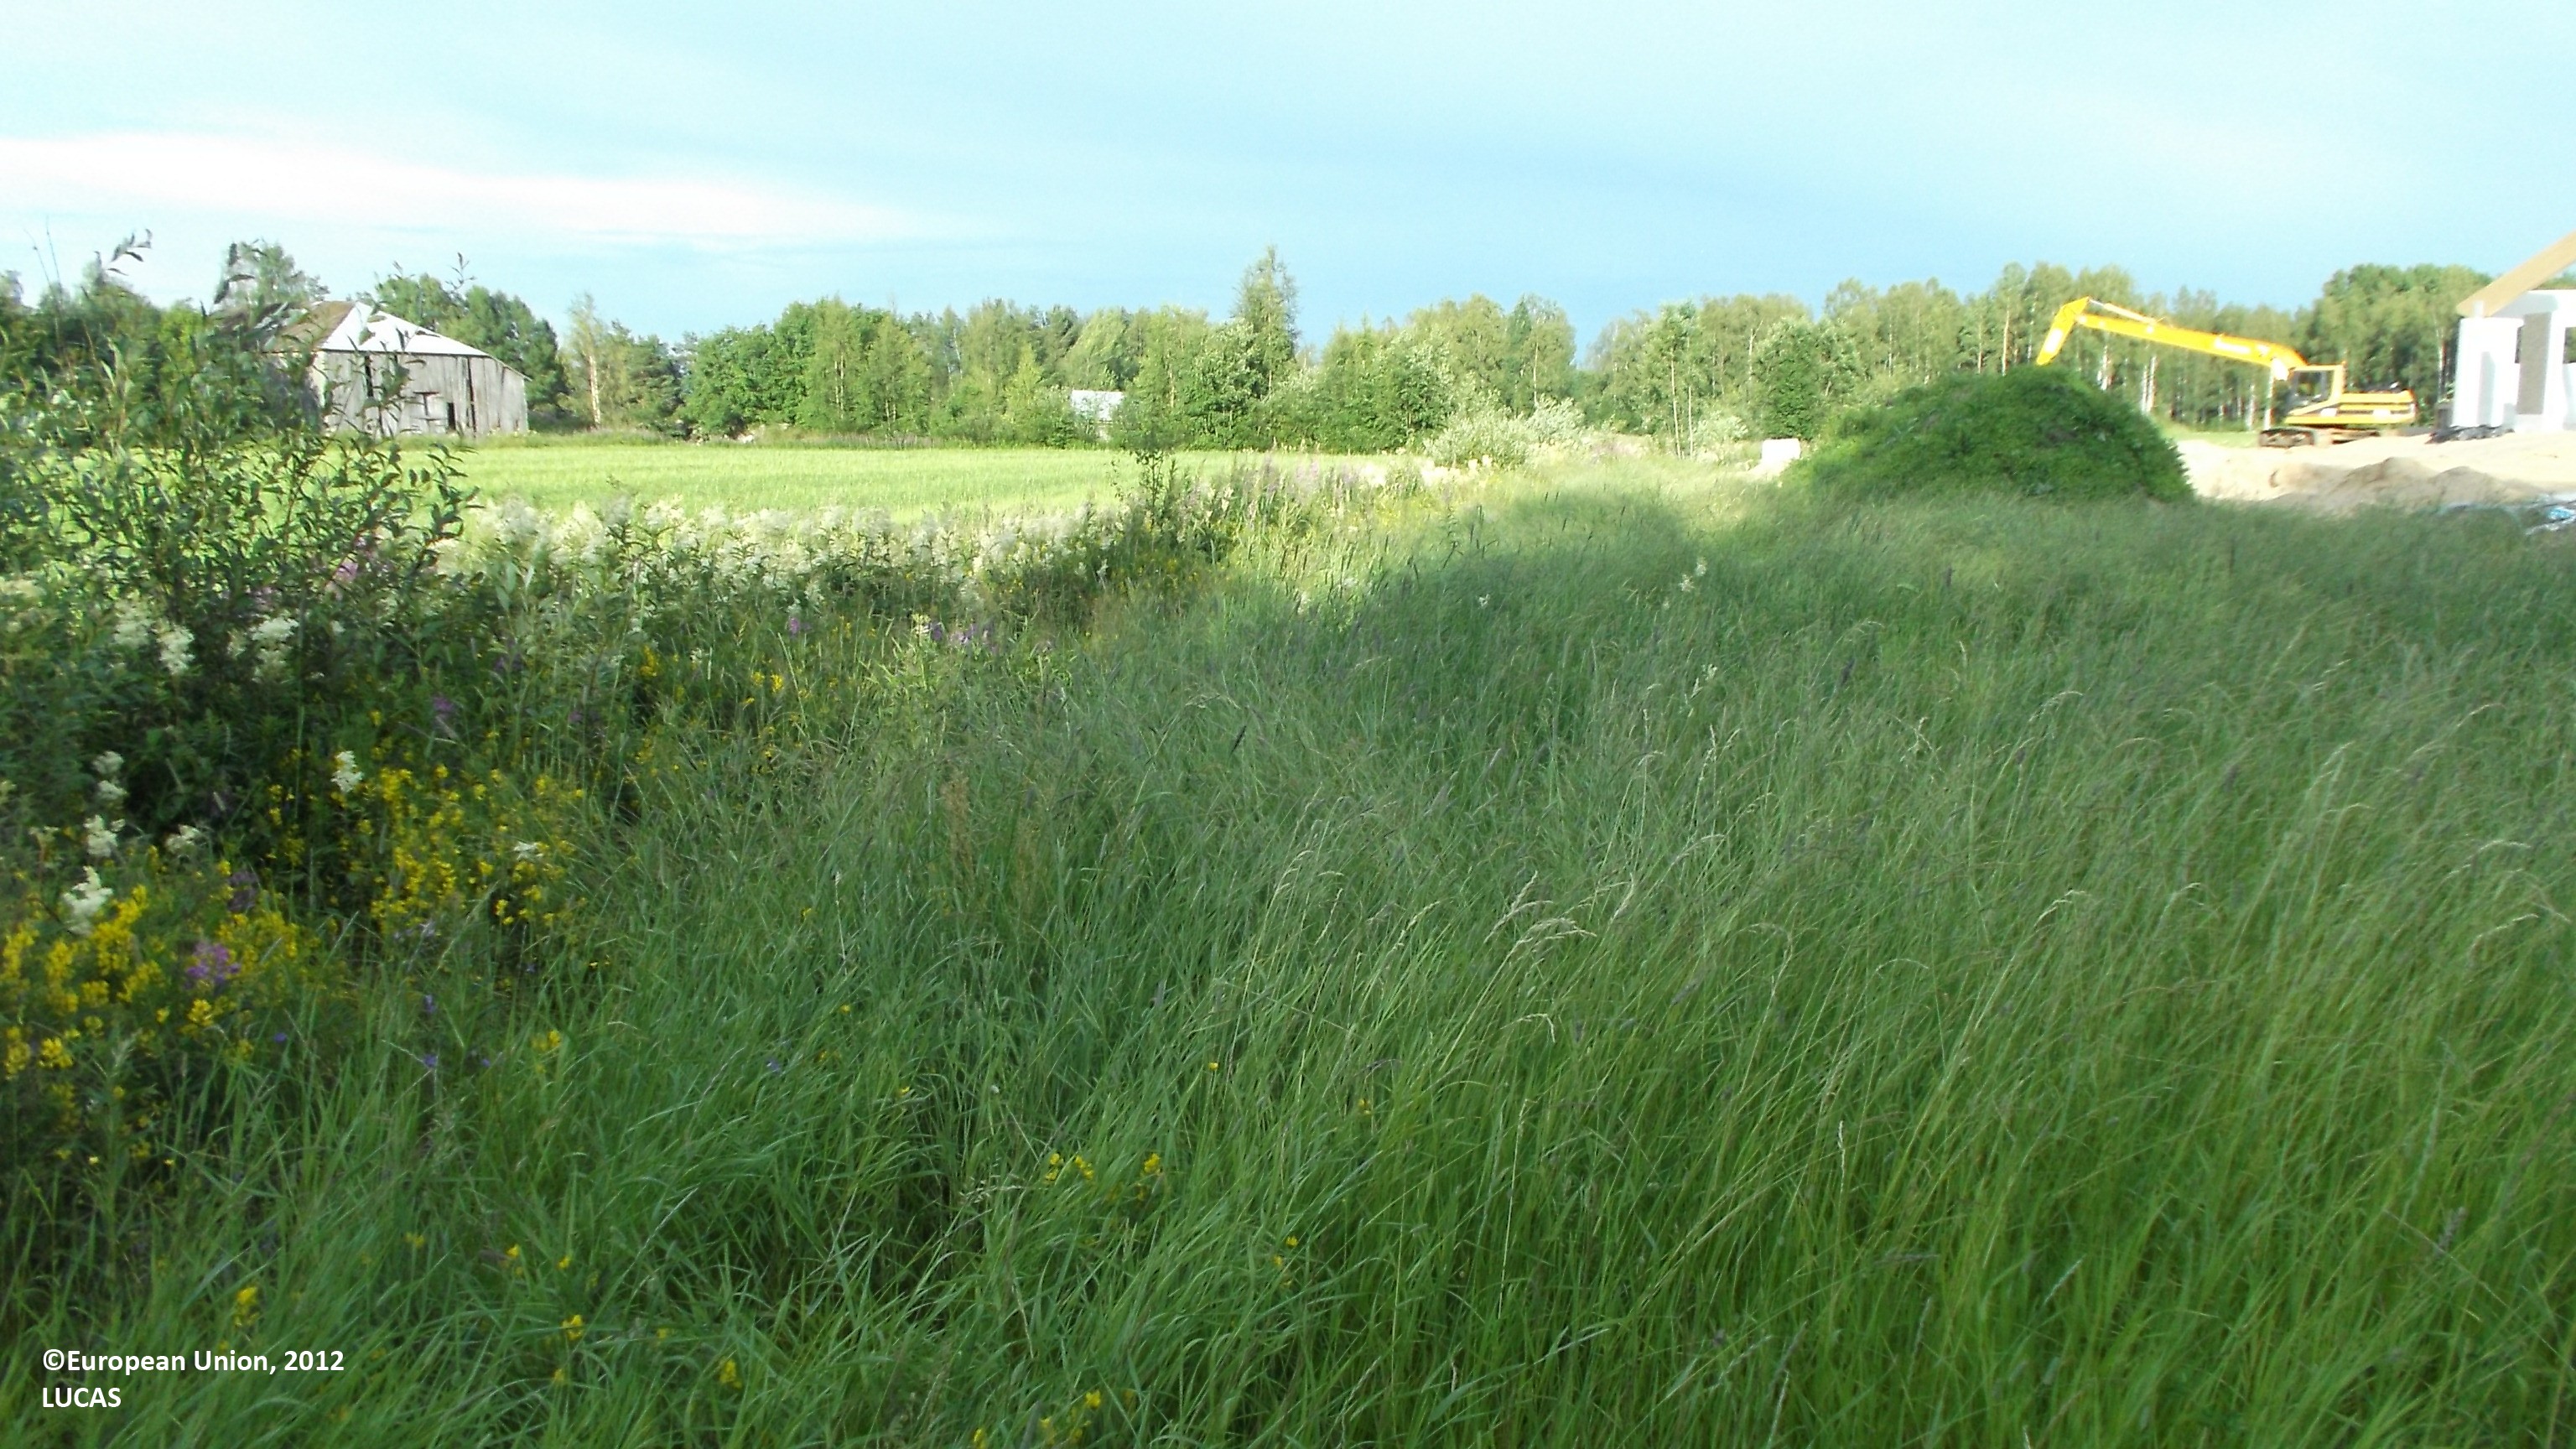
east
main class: Grassland
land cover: Grassland without tree/shrub cover
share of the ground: 50 - 75 %
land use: Fallow land
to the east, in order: Grassland without tree/shrub cover; Ditches and canals; Grass margins; Paved roads, cycling and walking lanes; Barley; Ditches and canals; Broadleaved woodland; Spontaneously vegetated surfaces; Barley; Ditches and canals; Rocks and stones; Broadleaved woodland
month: July
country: FI
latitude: 63.6430
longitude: 24.0199
